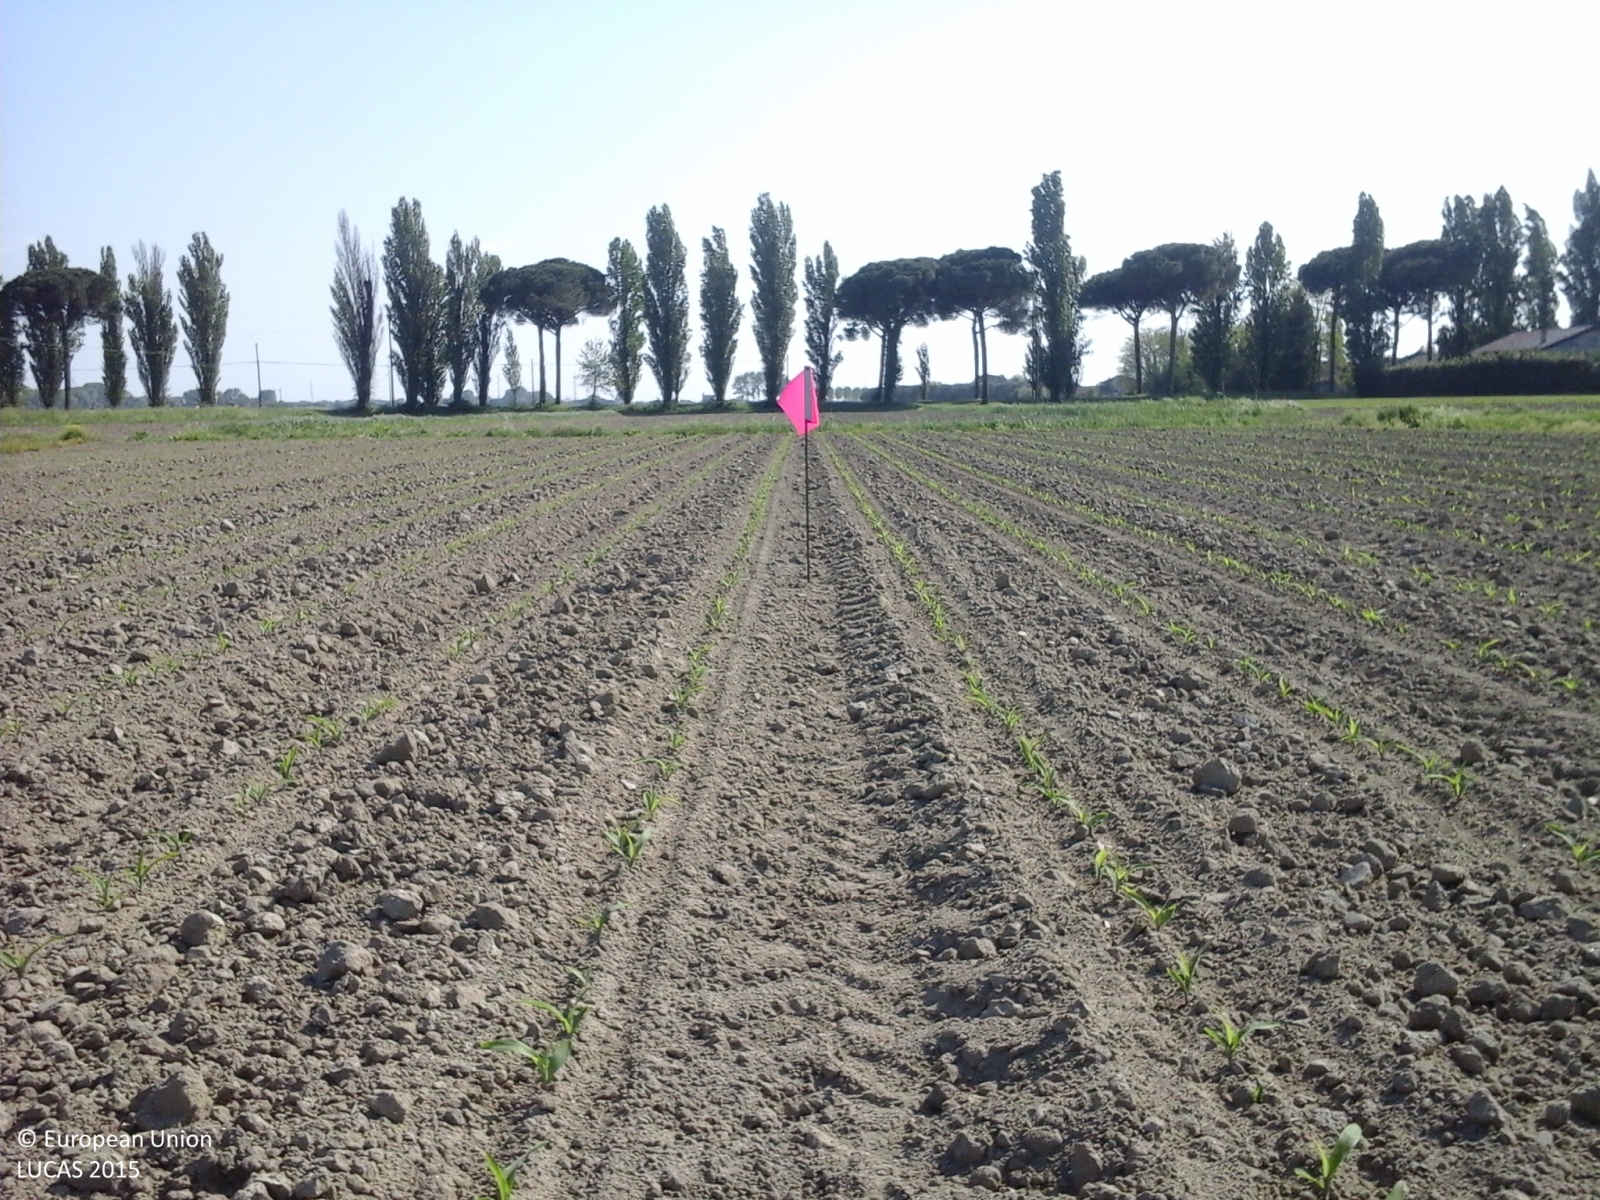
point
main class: Cropland
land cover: Maize
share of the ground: < 10 %
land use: Agriculture (excluding fallow land and kitchen gardens)
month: April
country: IT
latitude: 44.9212
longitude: 12.2635
